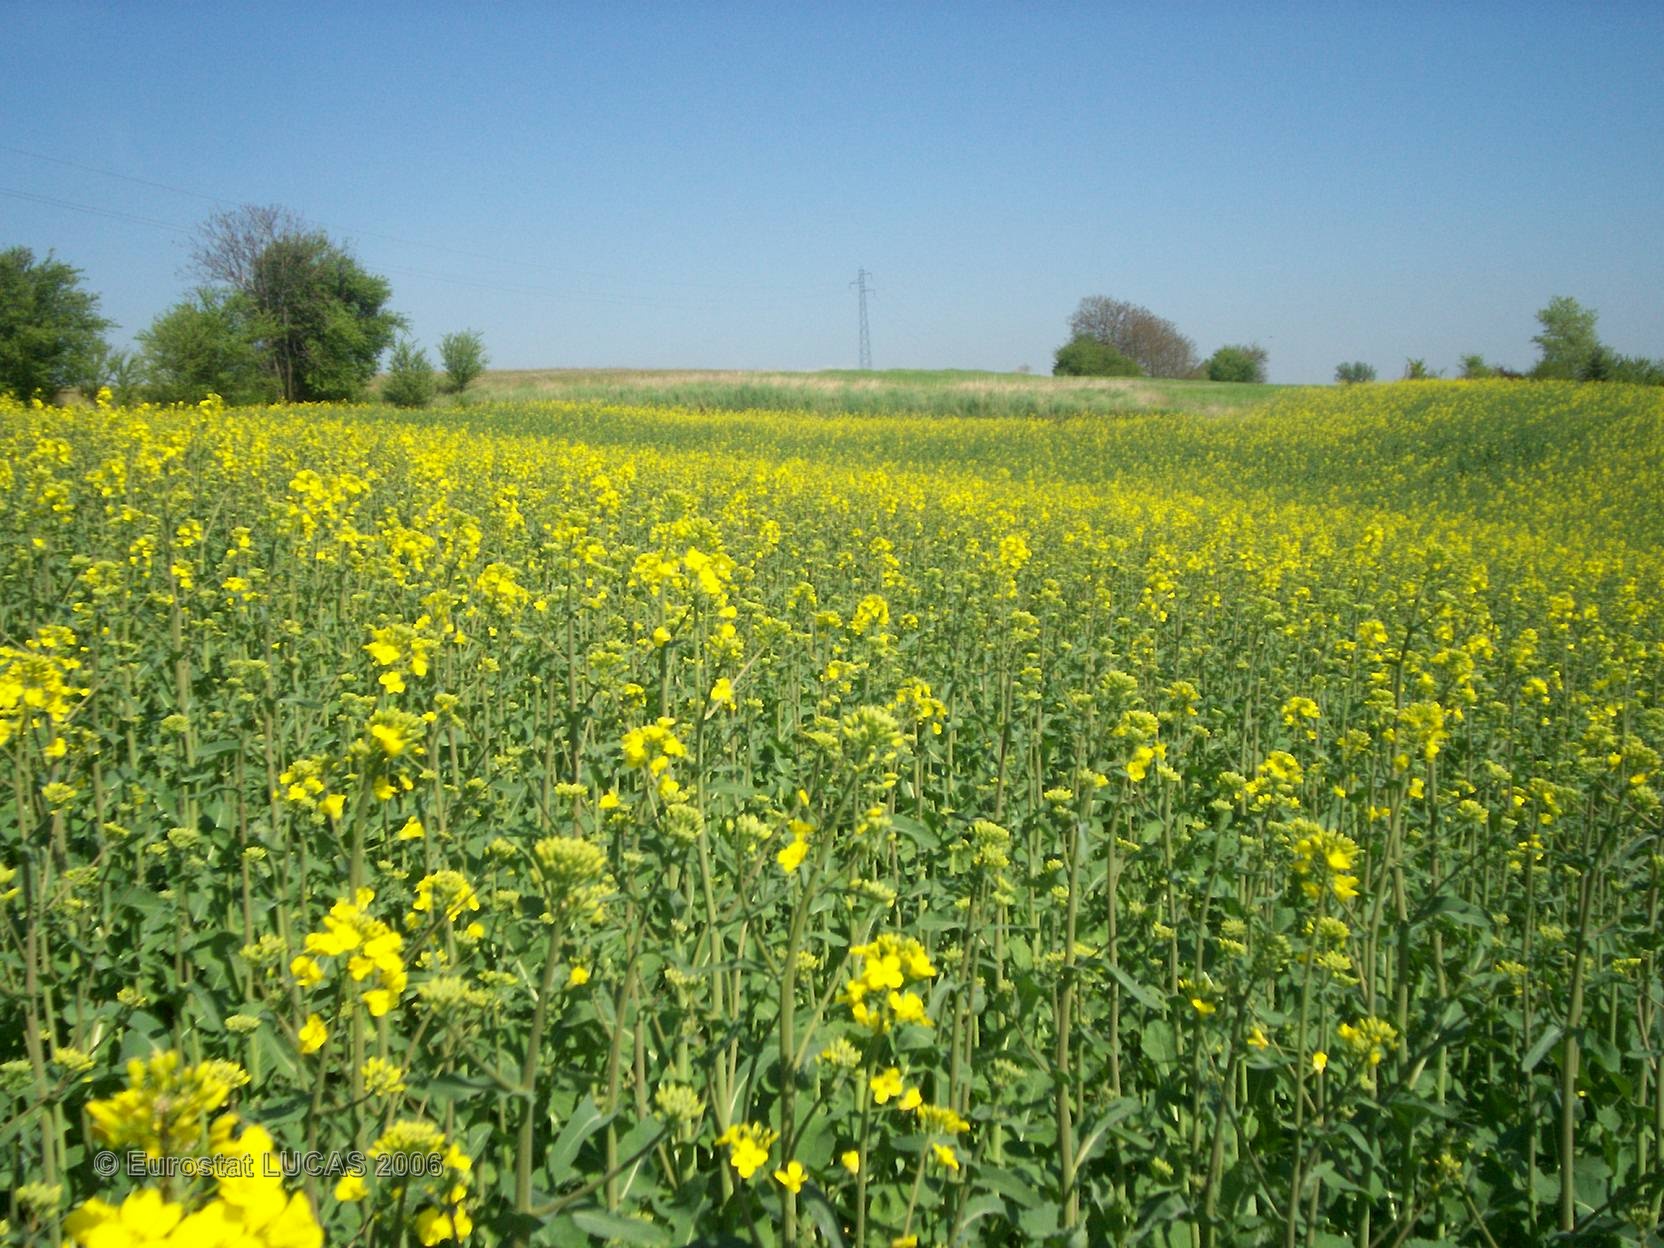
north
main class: Cropland
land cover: Rape and turnip rape
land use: Agriculture (excluding fallow land and kitchen gardens)
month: April
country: FR
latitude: 45.4678
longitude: 4.8242
